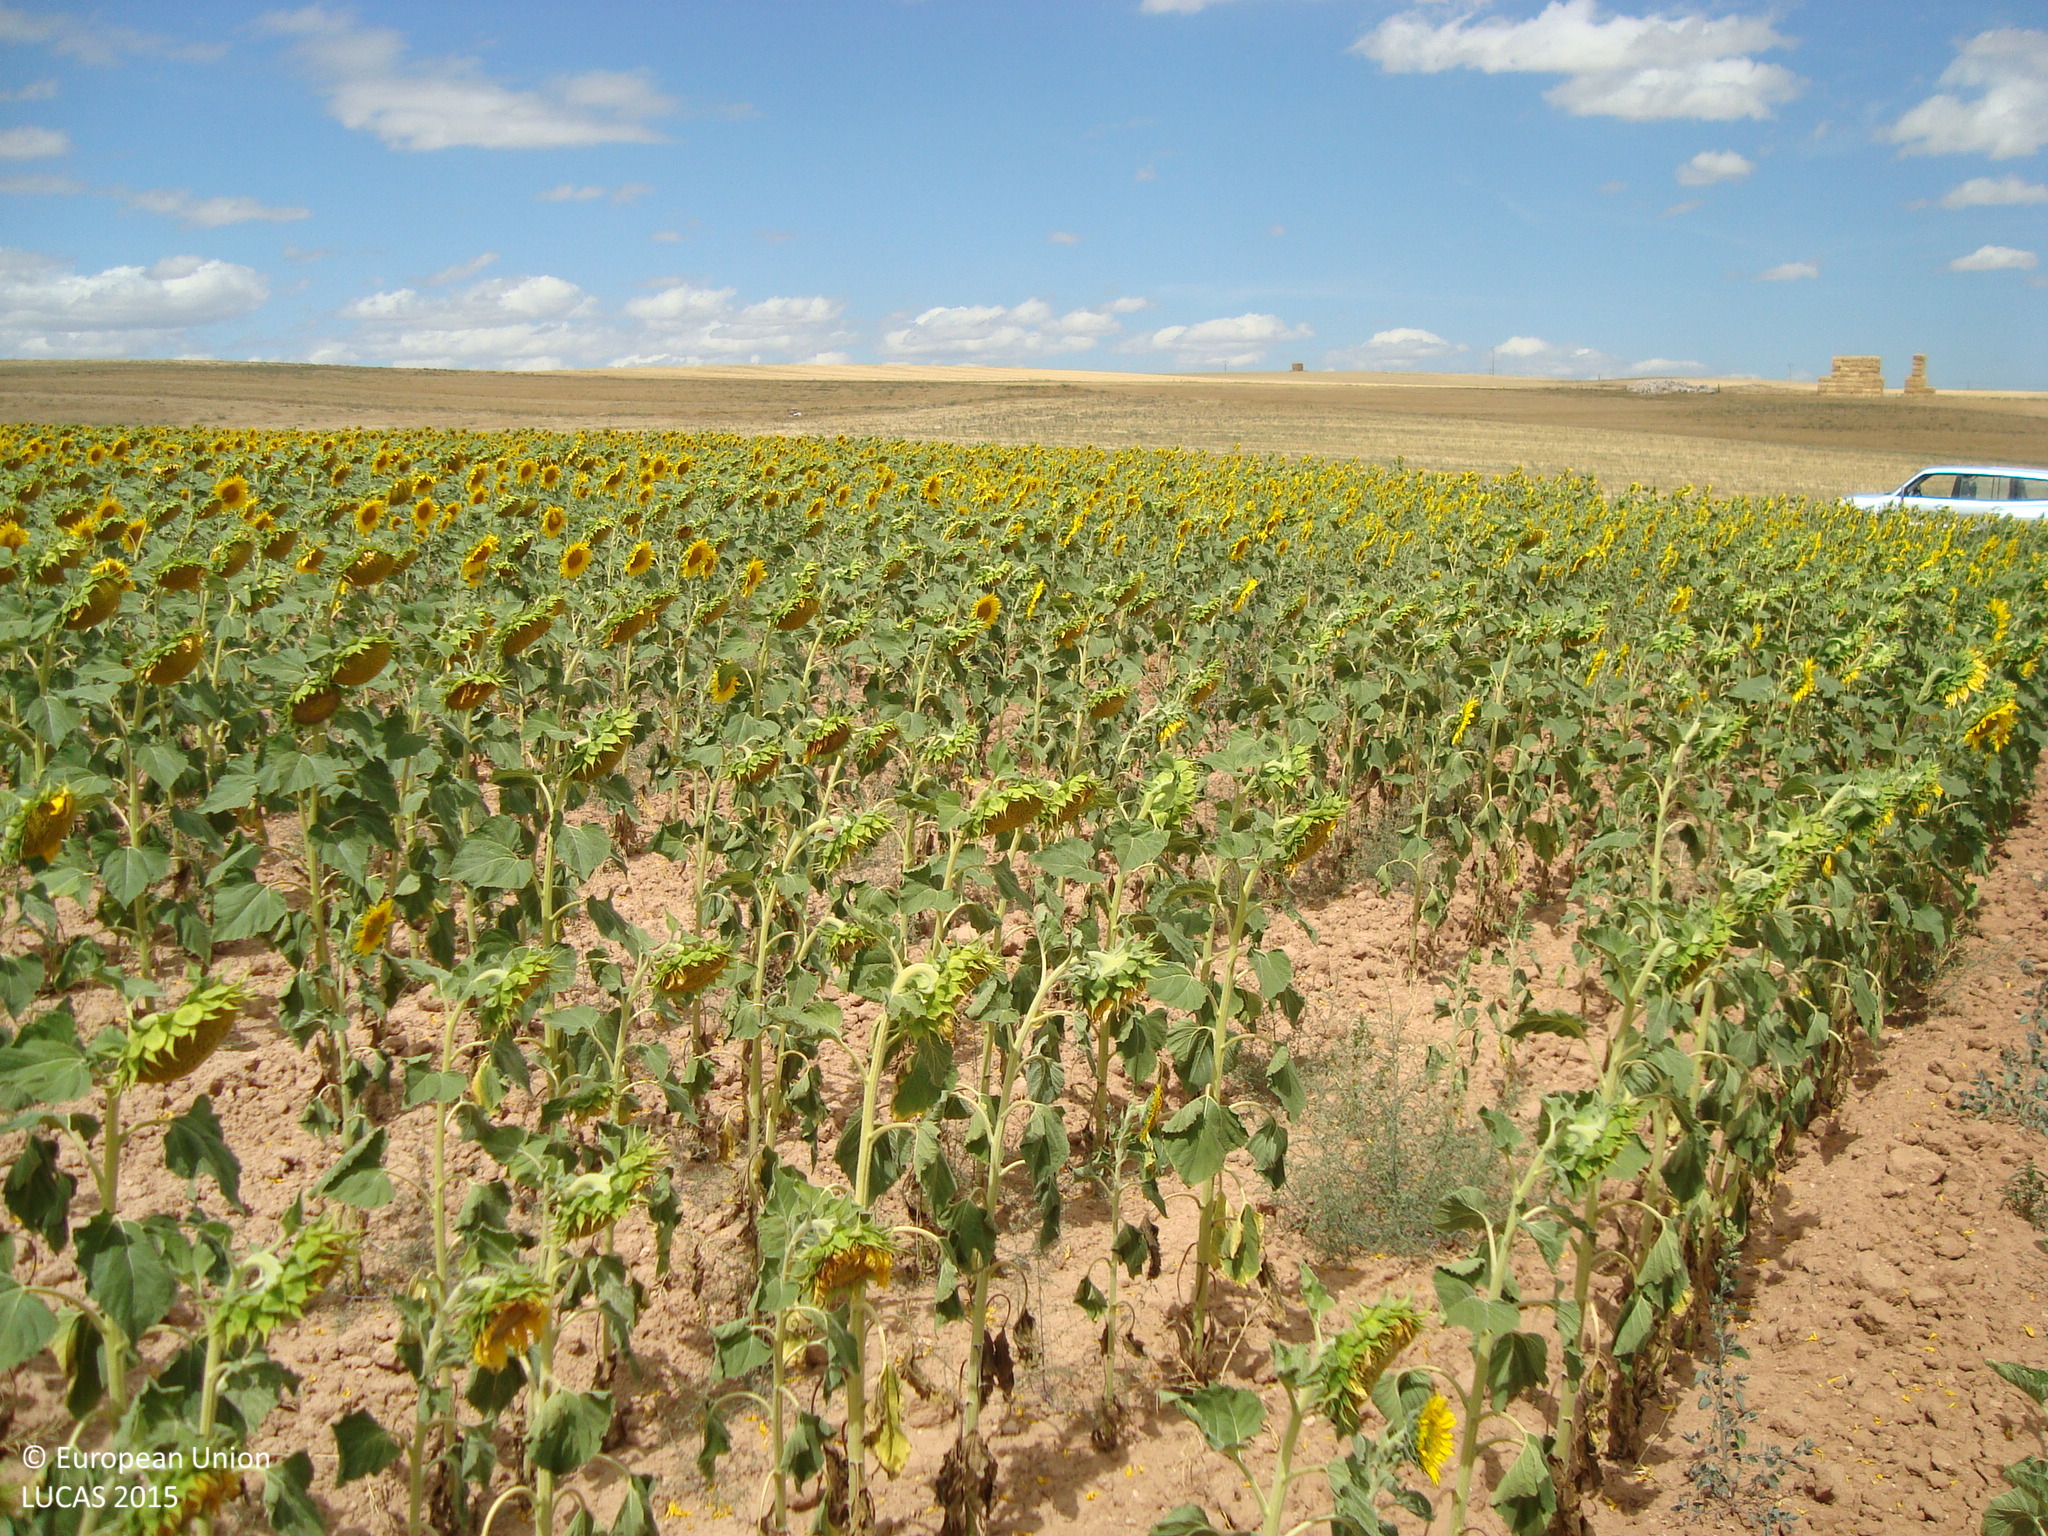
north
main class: Cropland
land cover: Sunflower
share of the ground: > 75 %
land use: Agriculture (excluding fallow land and kitchen gardens)
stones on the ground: < 10 %
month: August
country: ES
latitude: 42.0569
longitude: -3.8960
